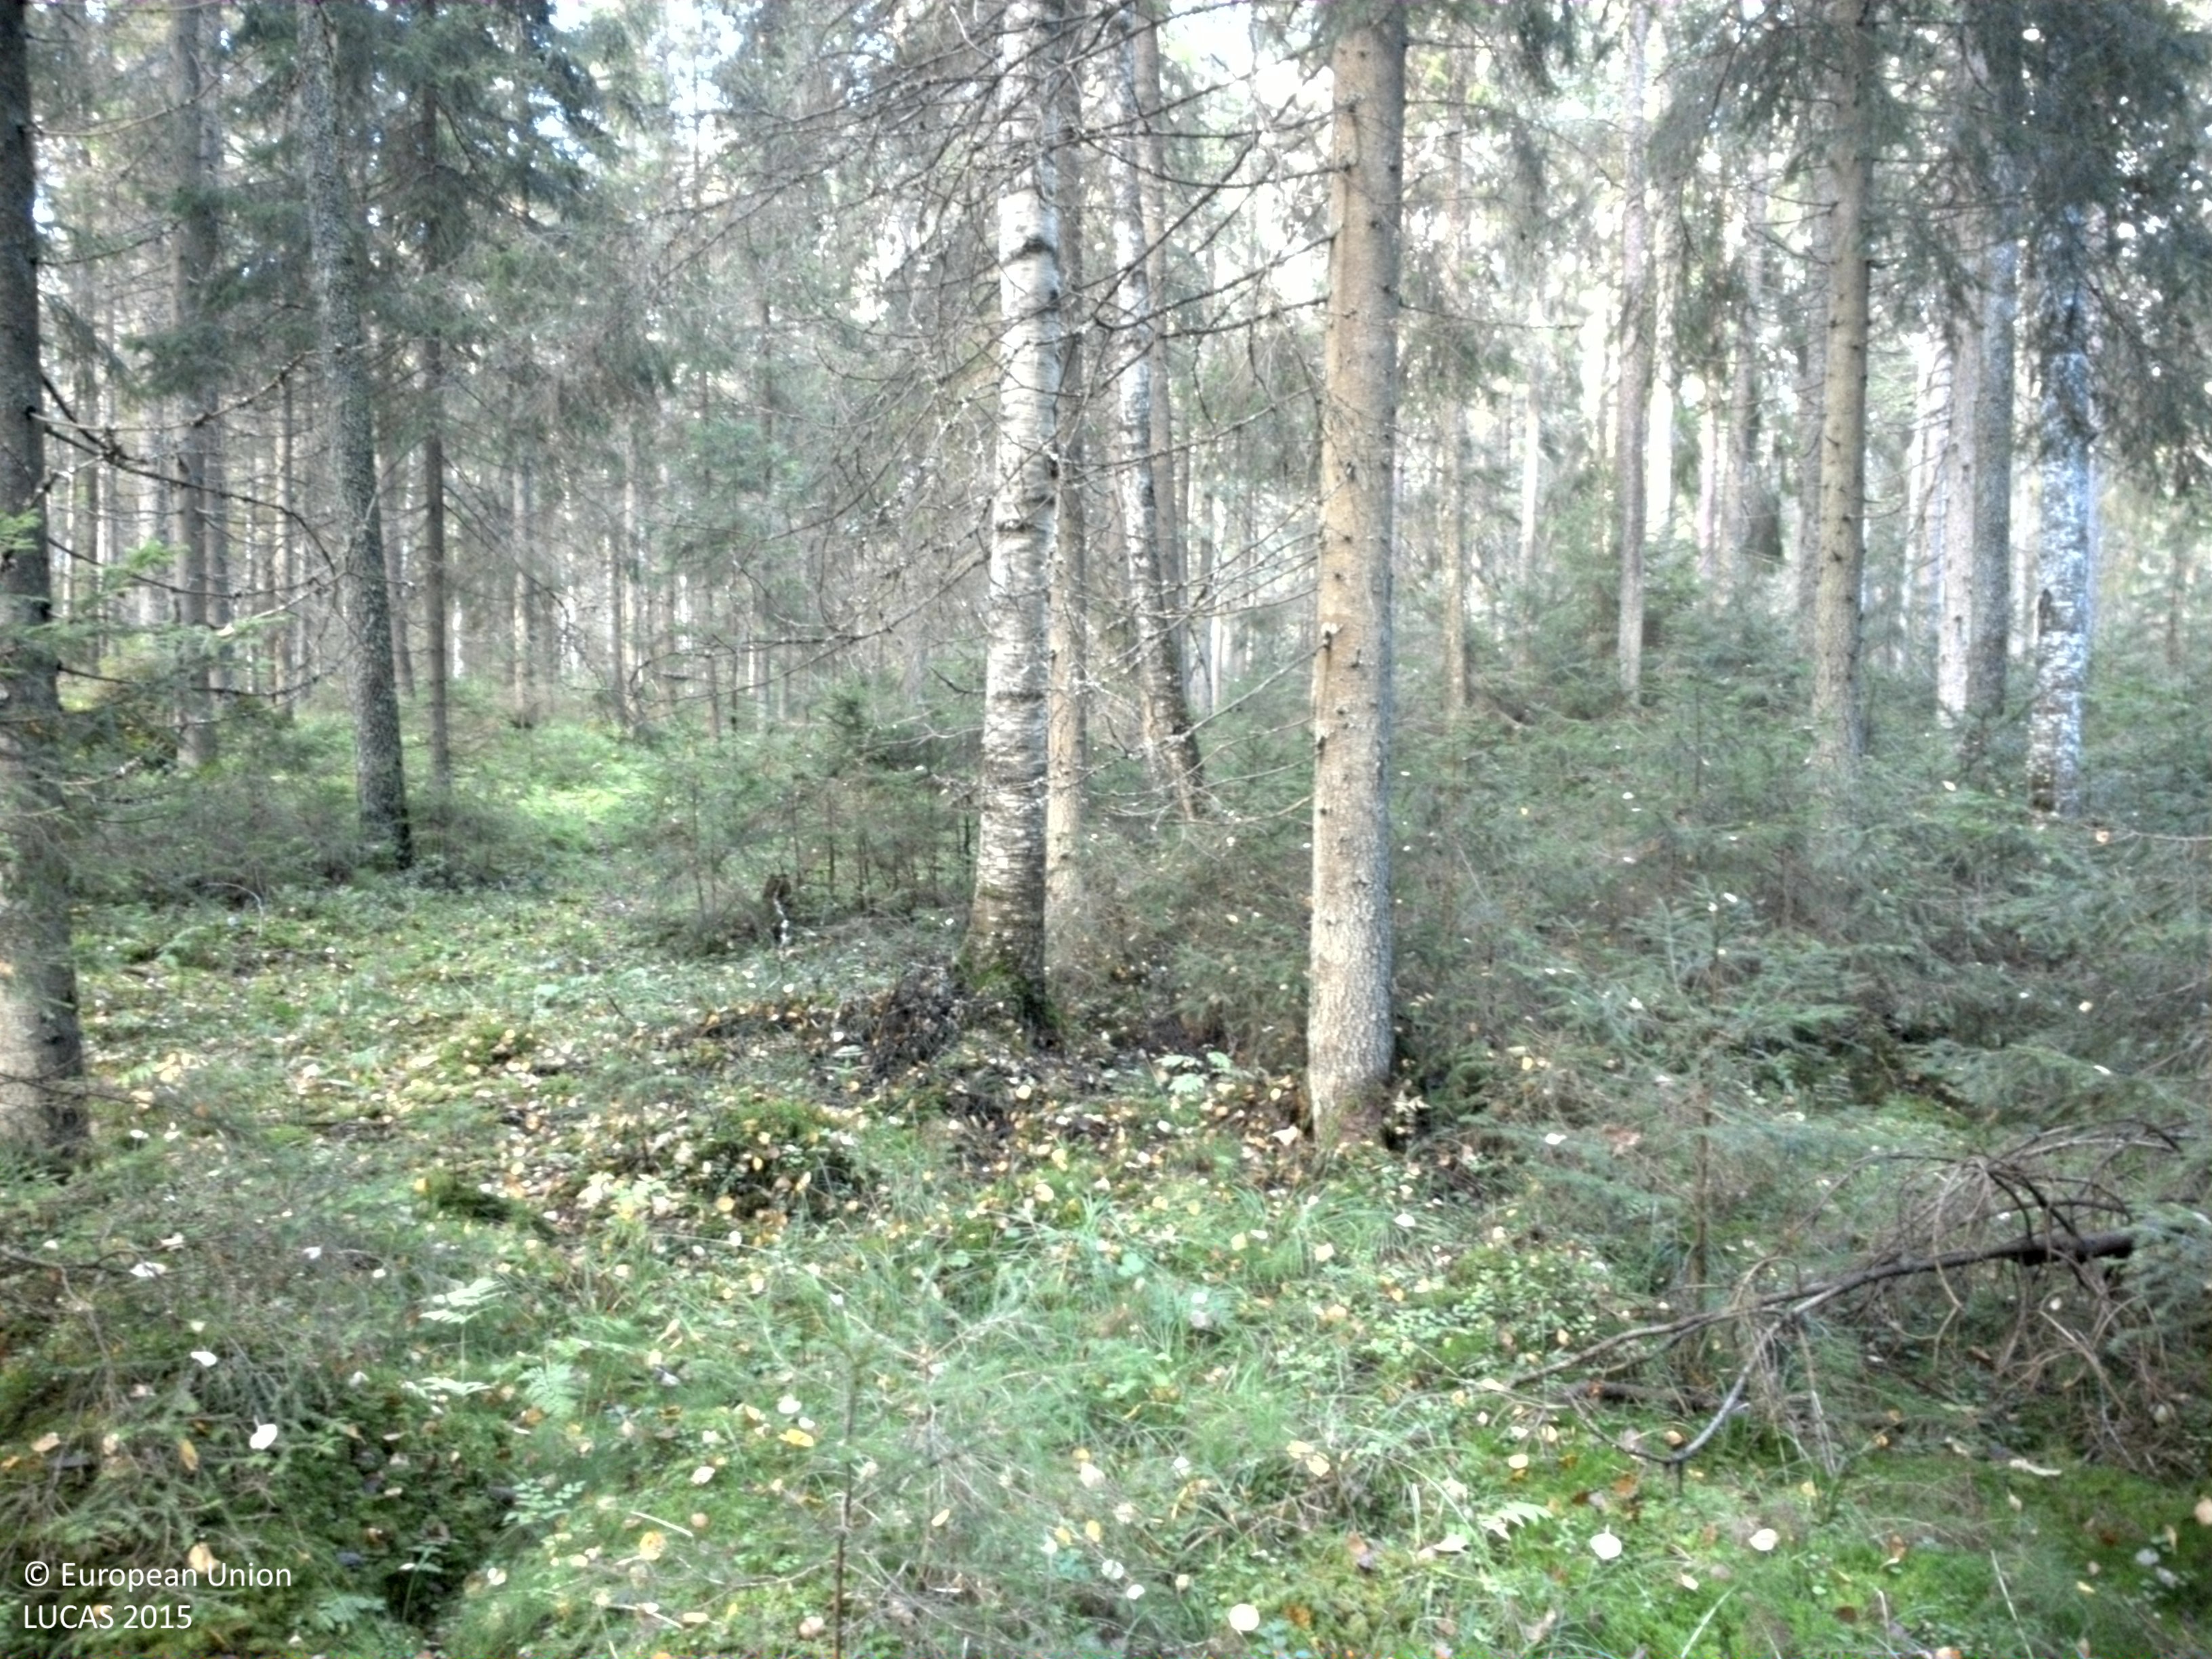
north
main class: Woodland
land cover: Spruce dominated mixed woodland
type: boreal forest
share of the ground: 50 - 75 %
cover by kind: coniferous forest trees 45 %, lichens and mosses 30 %, broadleaved forest trees 15 %, herbaceous plants 10 %
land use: Forestry
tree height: > 5 m
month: September
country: SE
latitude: 60.1347
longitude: 16.5975
